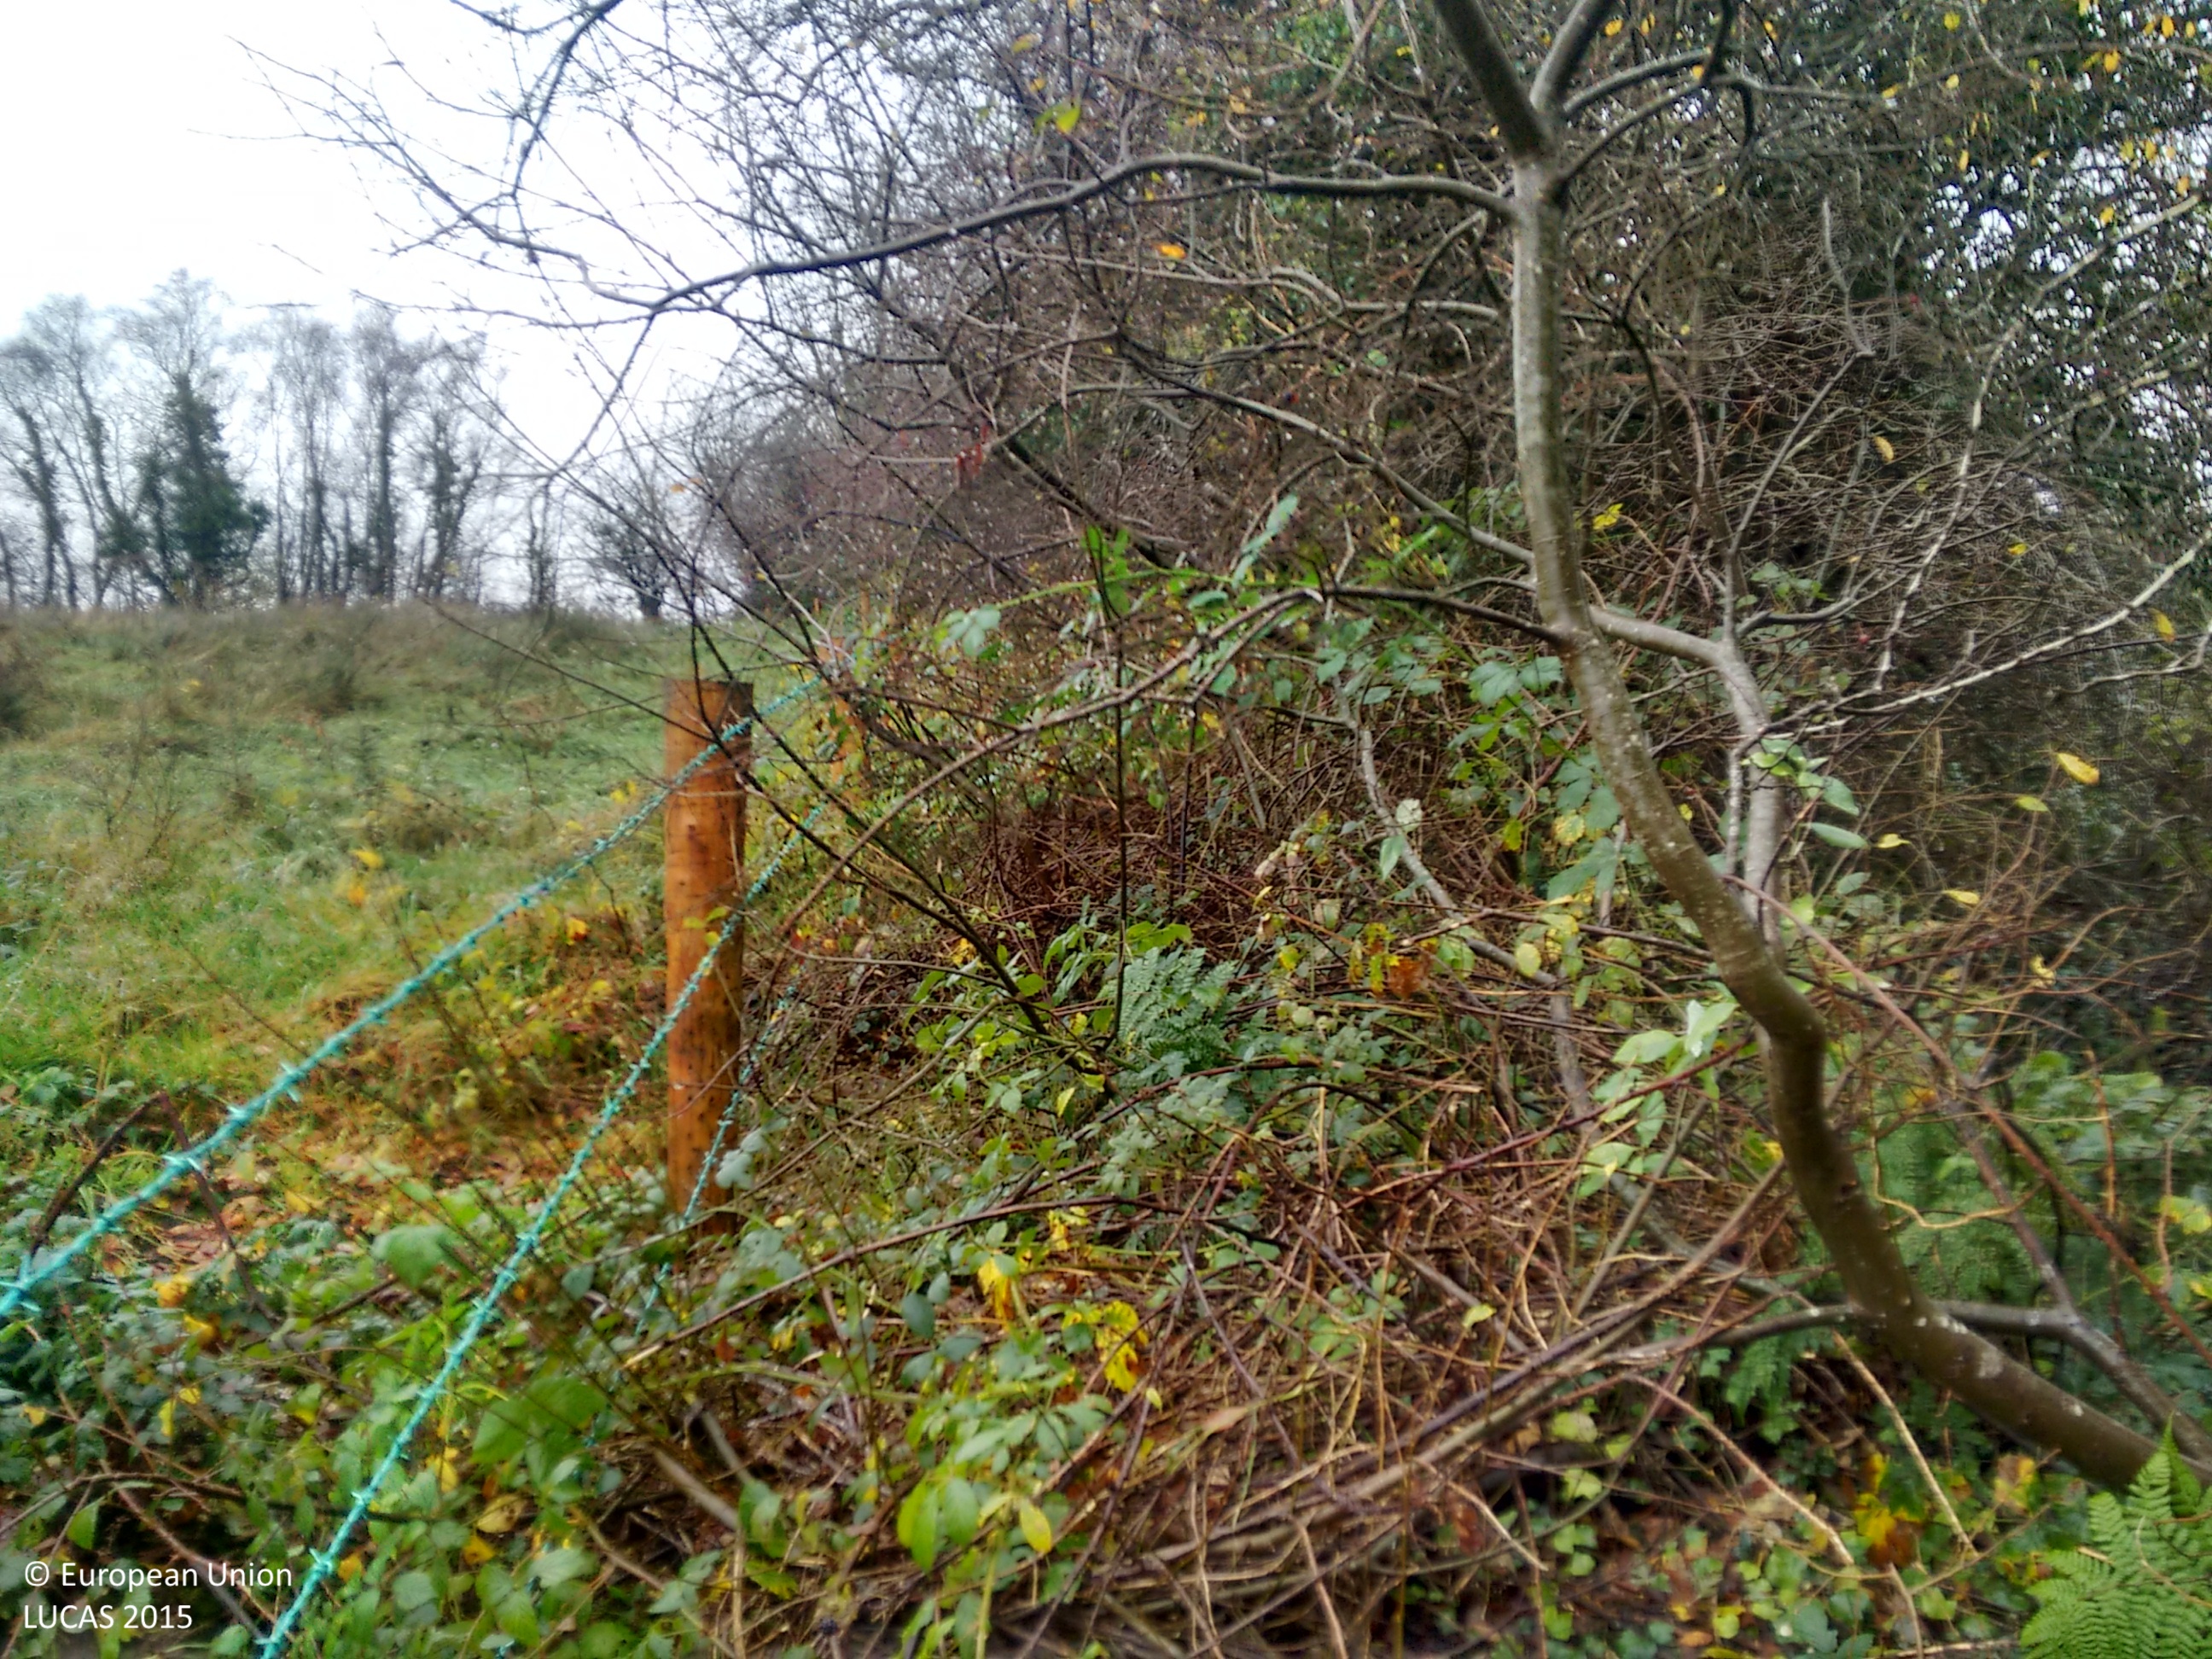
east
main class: Grassland
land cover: Spontaneously vegetated surfaces
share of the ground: > 75 %
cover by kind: herbaceous plants 95 %, shrubs 5 %
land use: Agriculture (excluding fallow land and kitchen gardens)
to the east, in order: Spontaneously vegetated surfaces; Fences; Abandoned hedges; Grassland without tree/shrub cover; Broadleaved woodland; Ditches and canals; Peatbogs; Ditches and canals; Peatbogs
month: November
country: IE
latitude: 53.9361
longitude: -7.8855
